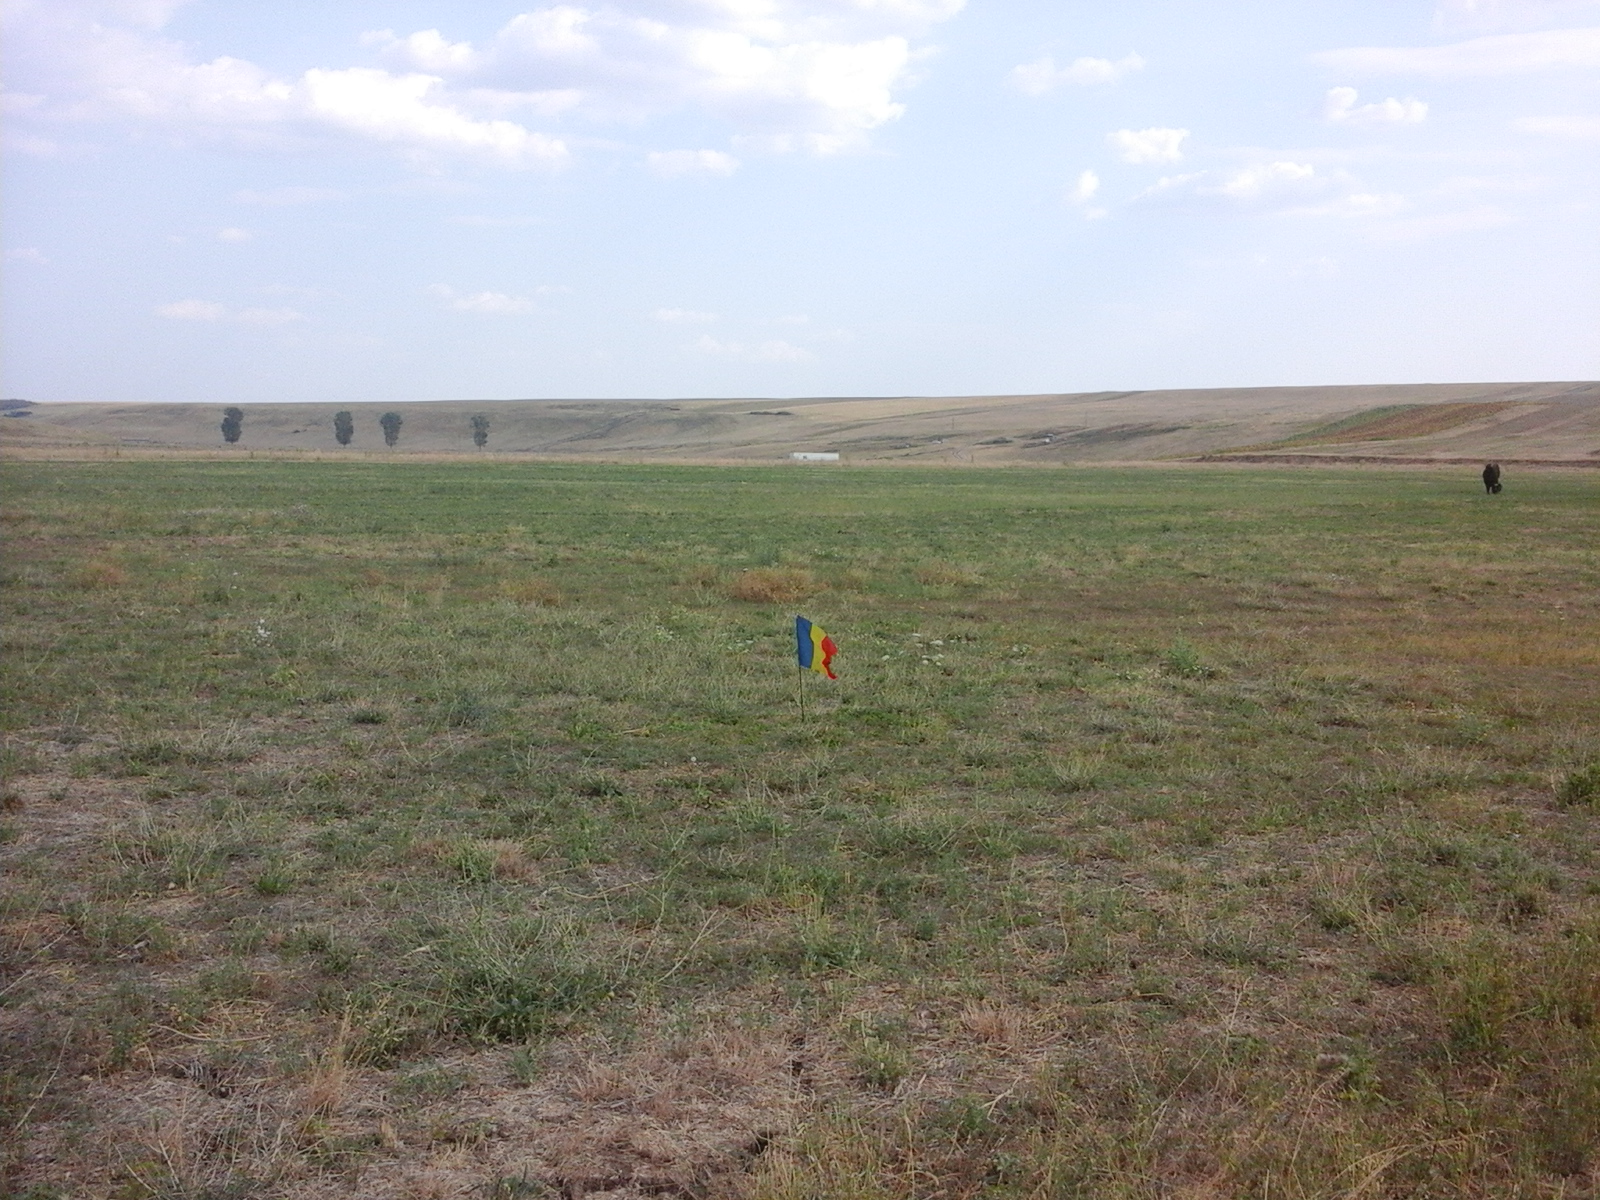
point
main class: Grassland
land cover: Grassland without tree/shrub cover
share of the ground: > 75 %
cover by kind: herbaceous plants 100 %
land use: Agriculture (excluding fallow land and kitchen gardens)
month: August
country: RO
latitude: 44.2972
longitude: 23.2710
